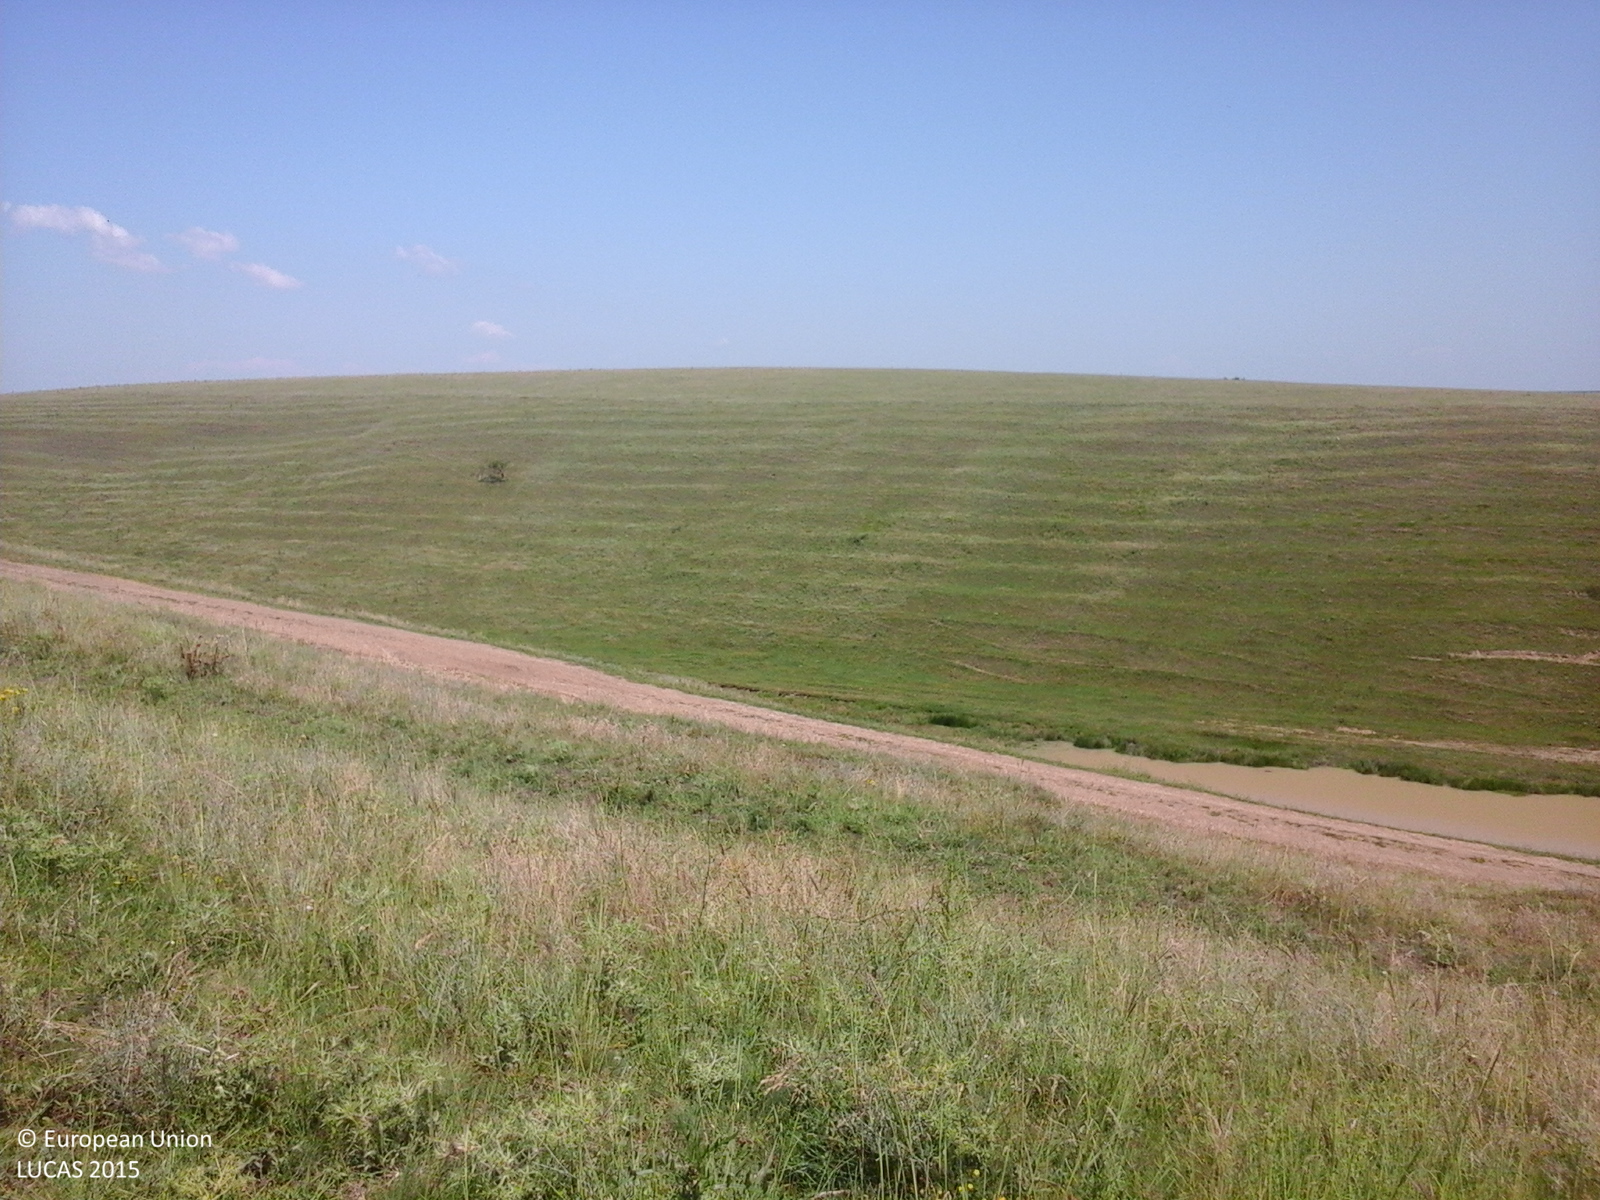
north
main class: Grassland
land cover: Grassland without tree/shrub cover
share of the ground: > 75 %
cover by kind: herbaceous plants 100 %
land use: Agriculture (excluding fallow land and kitchen gardens)
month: July
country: RO
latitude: 44.4835
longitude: 24.5951
